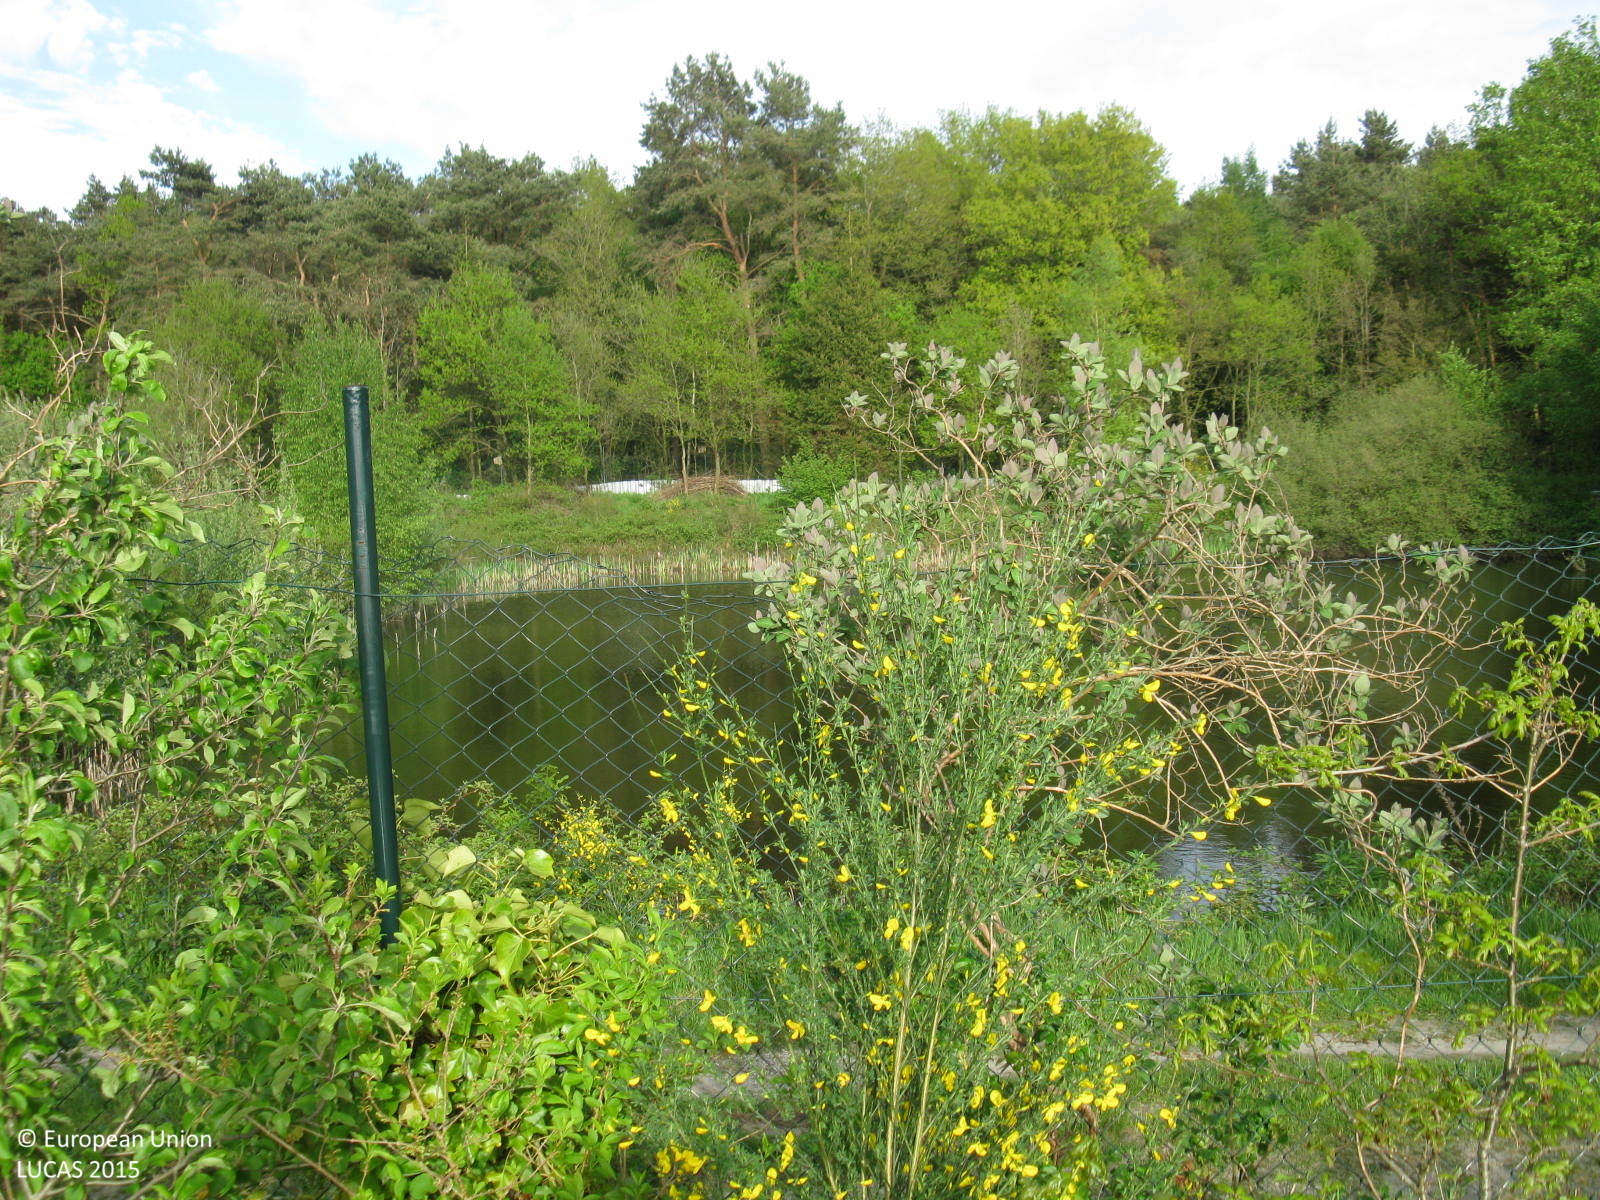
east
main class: Woodland
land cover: Broadleaved woodland
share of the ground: 25 - 50 %
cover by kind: broadleaved forest trees 50 %, herbaceous plants 50 %
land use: Semi-natural and natural areas not in use
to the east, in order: Broadleaved woodland; Fences; Tracks; Shrubland without tree cover; Grassland without tree/shrub cover; Broadleaved woodland; Fences; Pine dominated coniferous woodland; Tracks; Grassland without tree/shrub cover
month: May
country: DE
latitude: 52.9603
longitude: 7.3953
